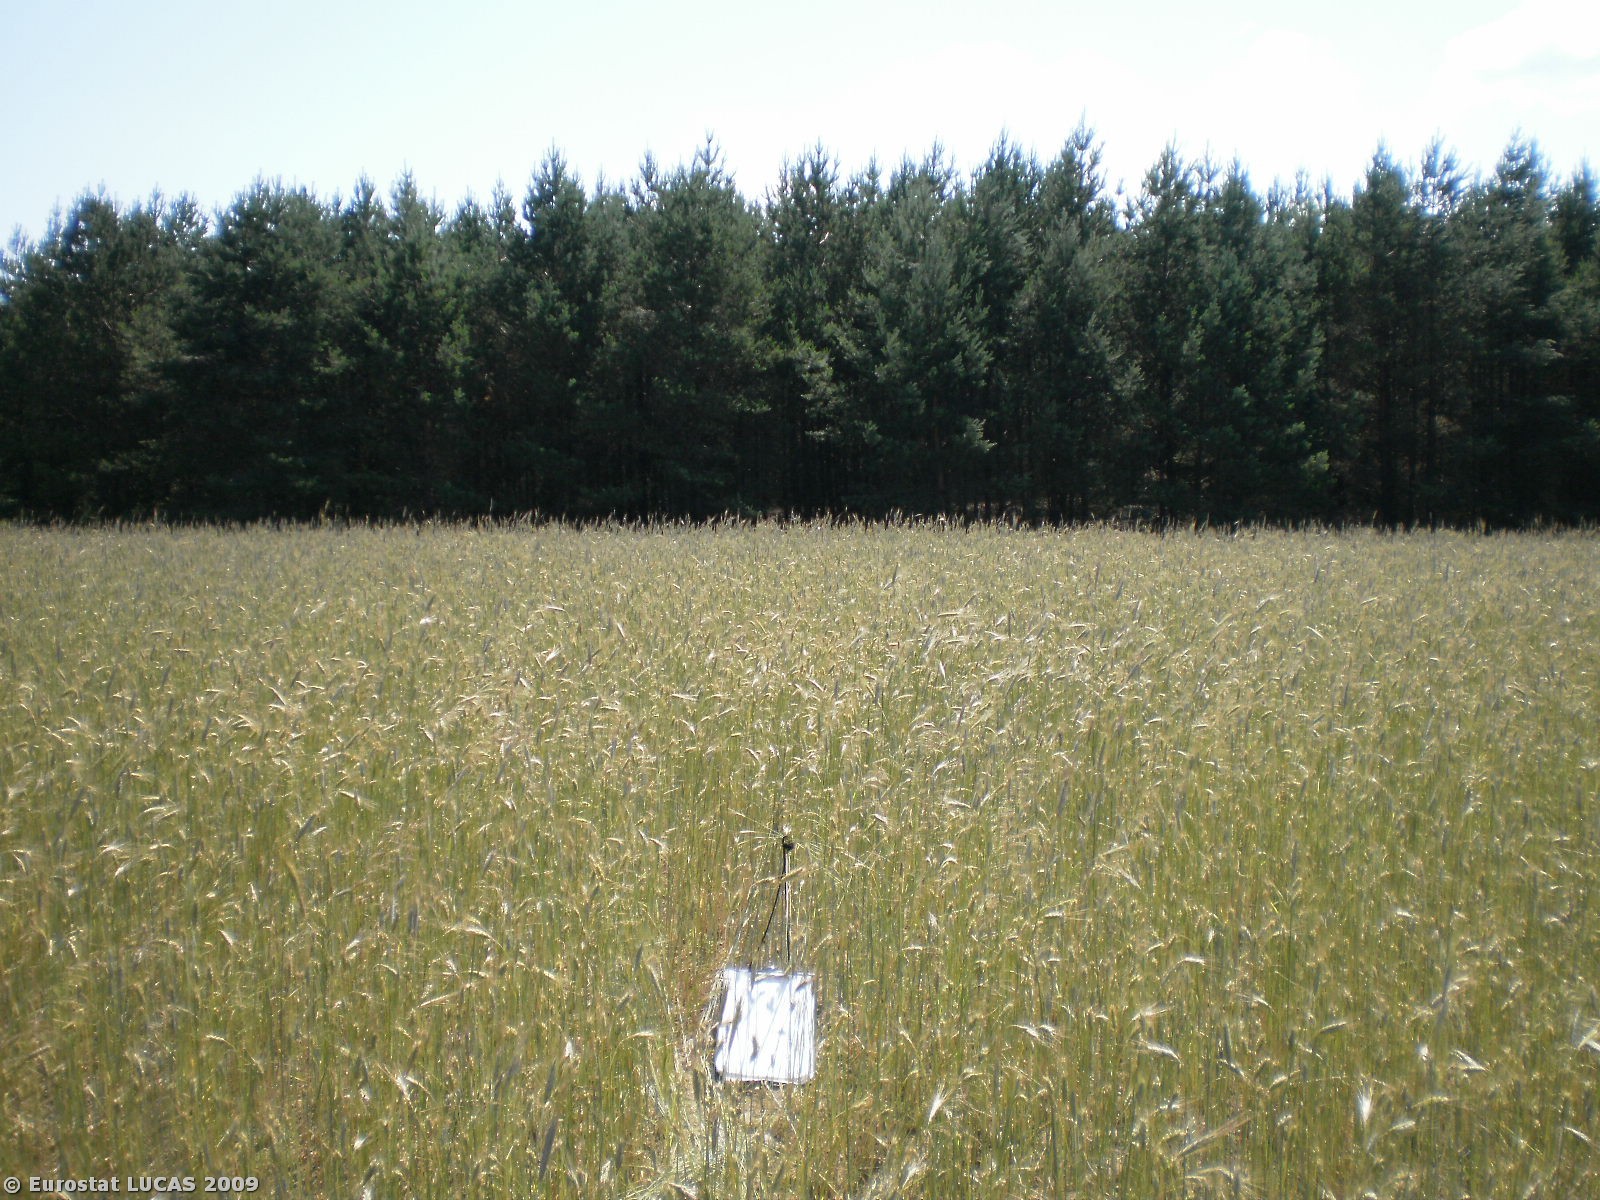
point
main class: Cropland
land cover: Rye
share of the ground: > 75 %
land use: Agriculture (excluding fallow land and kitchen gardens)
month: July
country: PL
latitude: 54.1969
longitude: 17.8148
